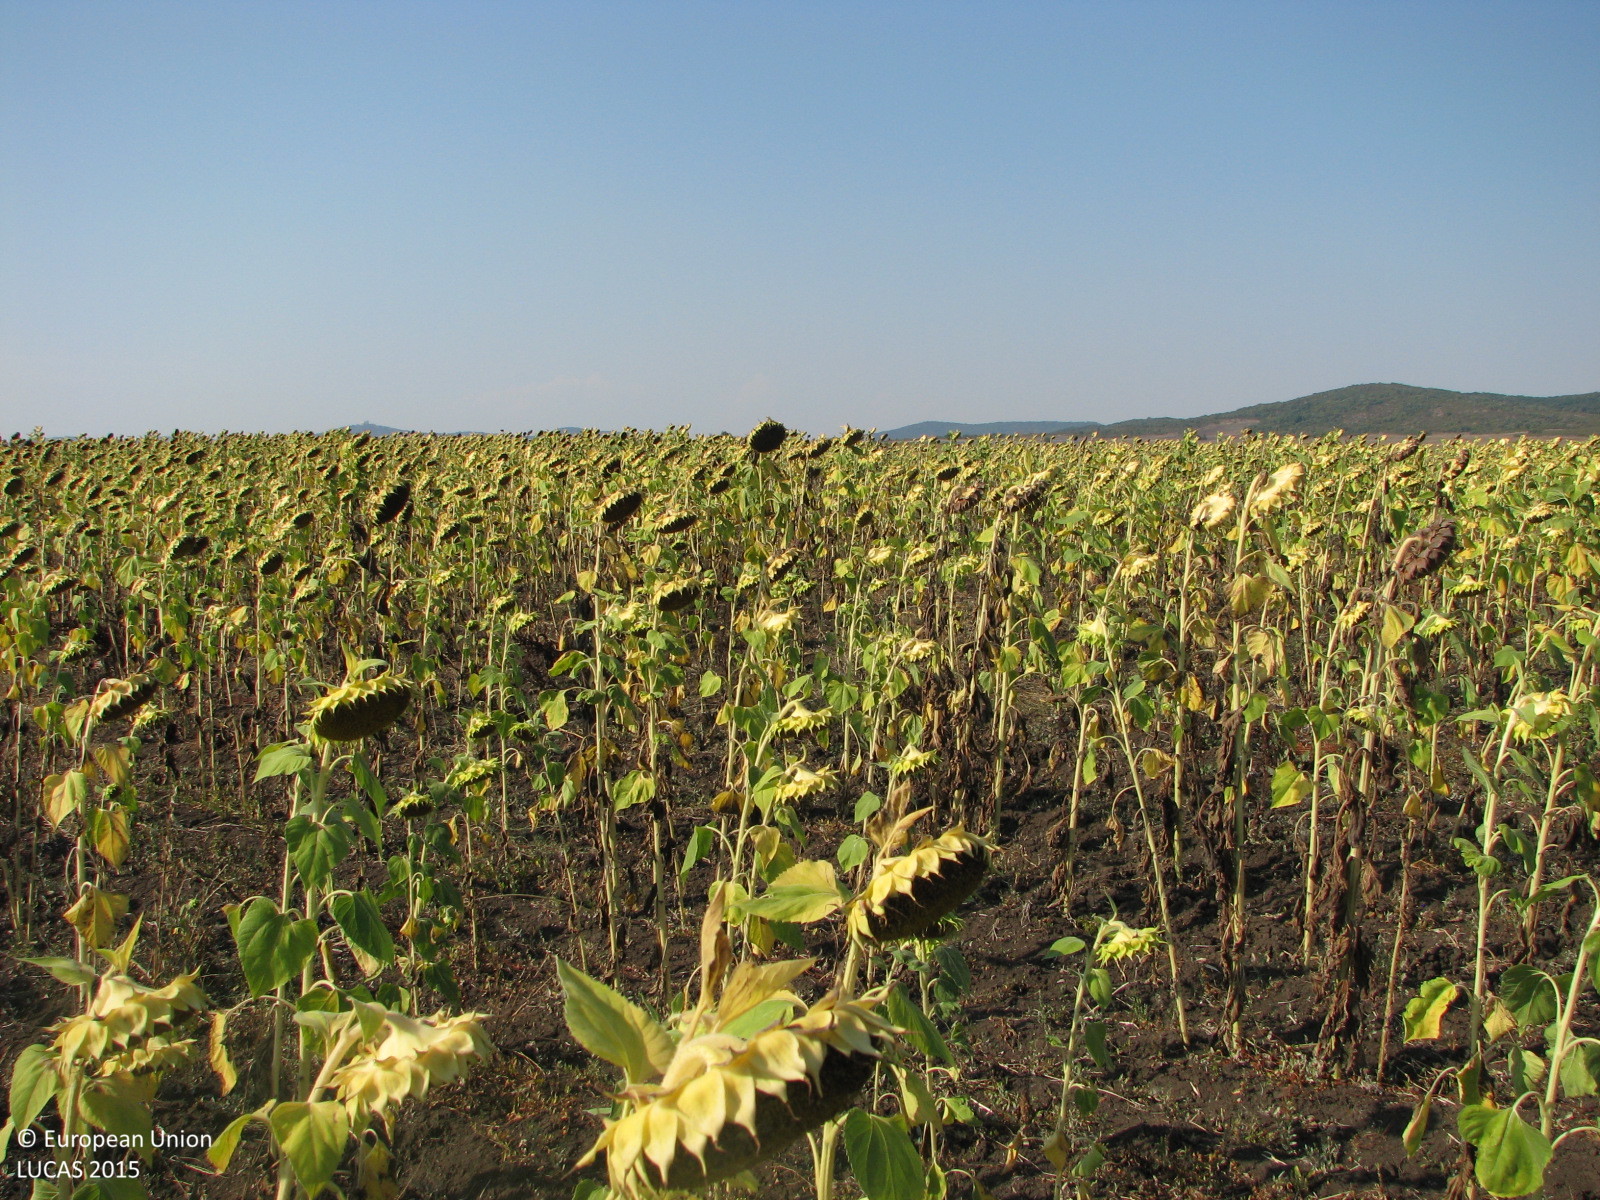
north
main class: Cropland
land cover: Sunflower
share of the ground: > 75 %
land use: Agriculture (excluding fallow land and kitchen gardens)
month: September
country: BG
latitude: 42.3749
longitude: 26.7216
